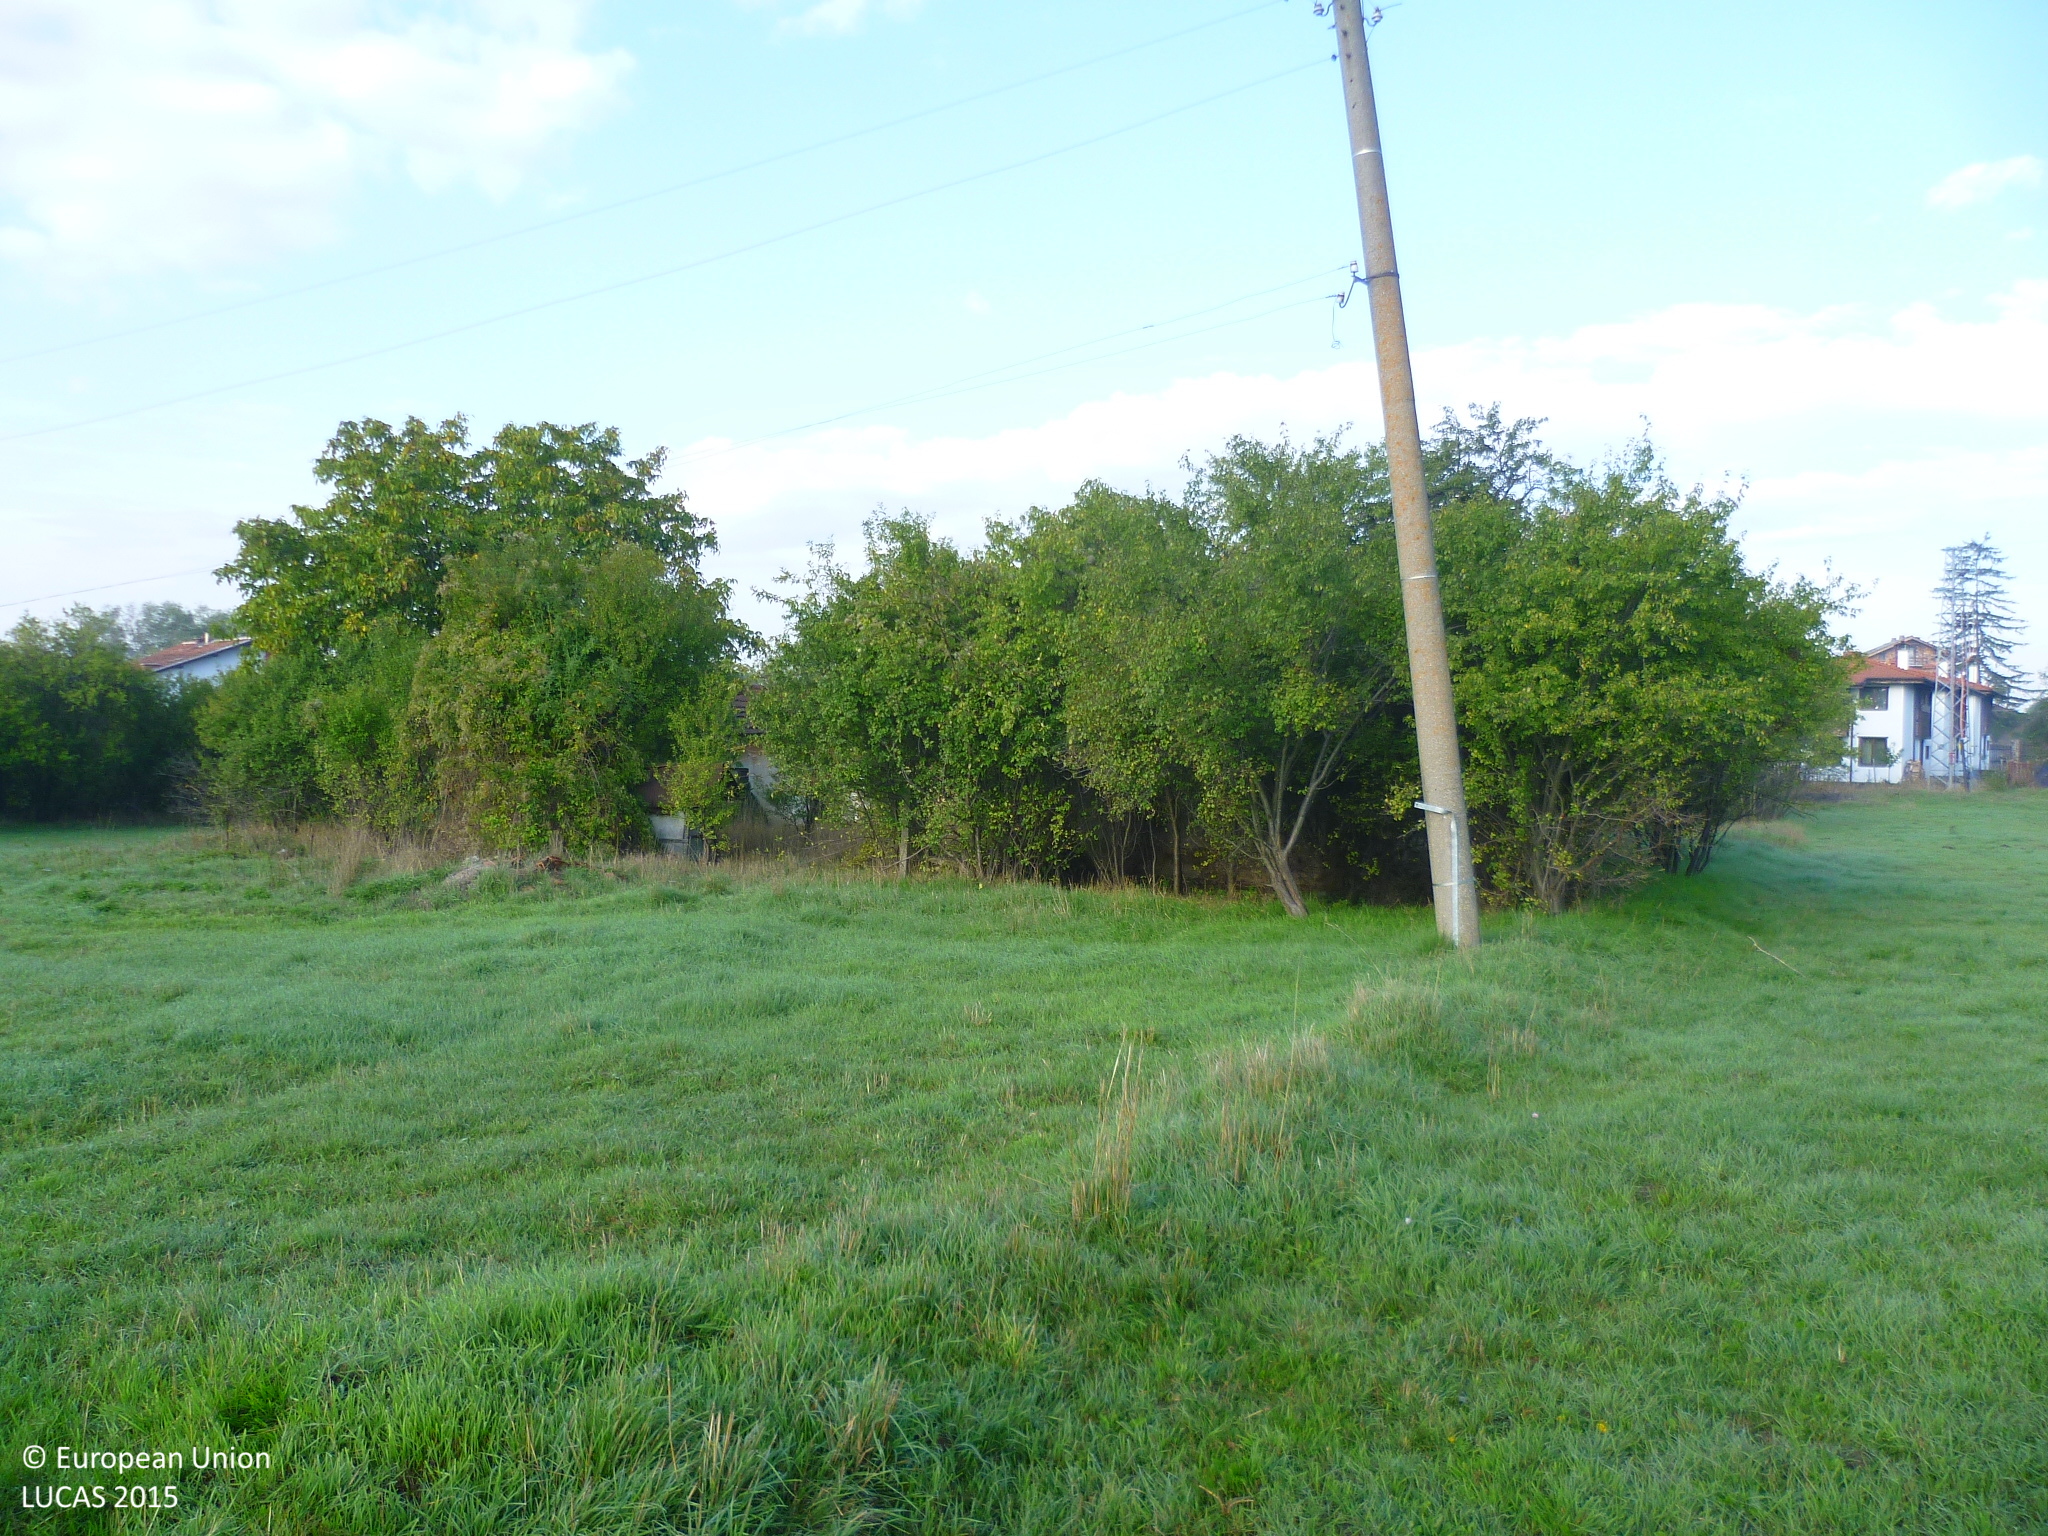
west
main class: Grassland
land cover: Grassland without tree/shrub cover
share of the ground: > 75 %
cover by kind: herbaceous plants 100 %
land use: Agriculture (excluding fallow land and kitchen gardens)
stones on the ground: < 10 %
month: October
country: BG
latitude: 42.8546
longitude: 22.9911
